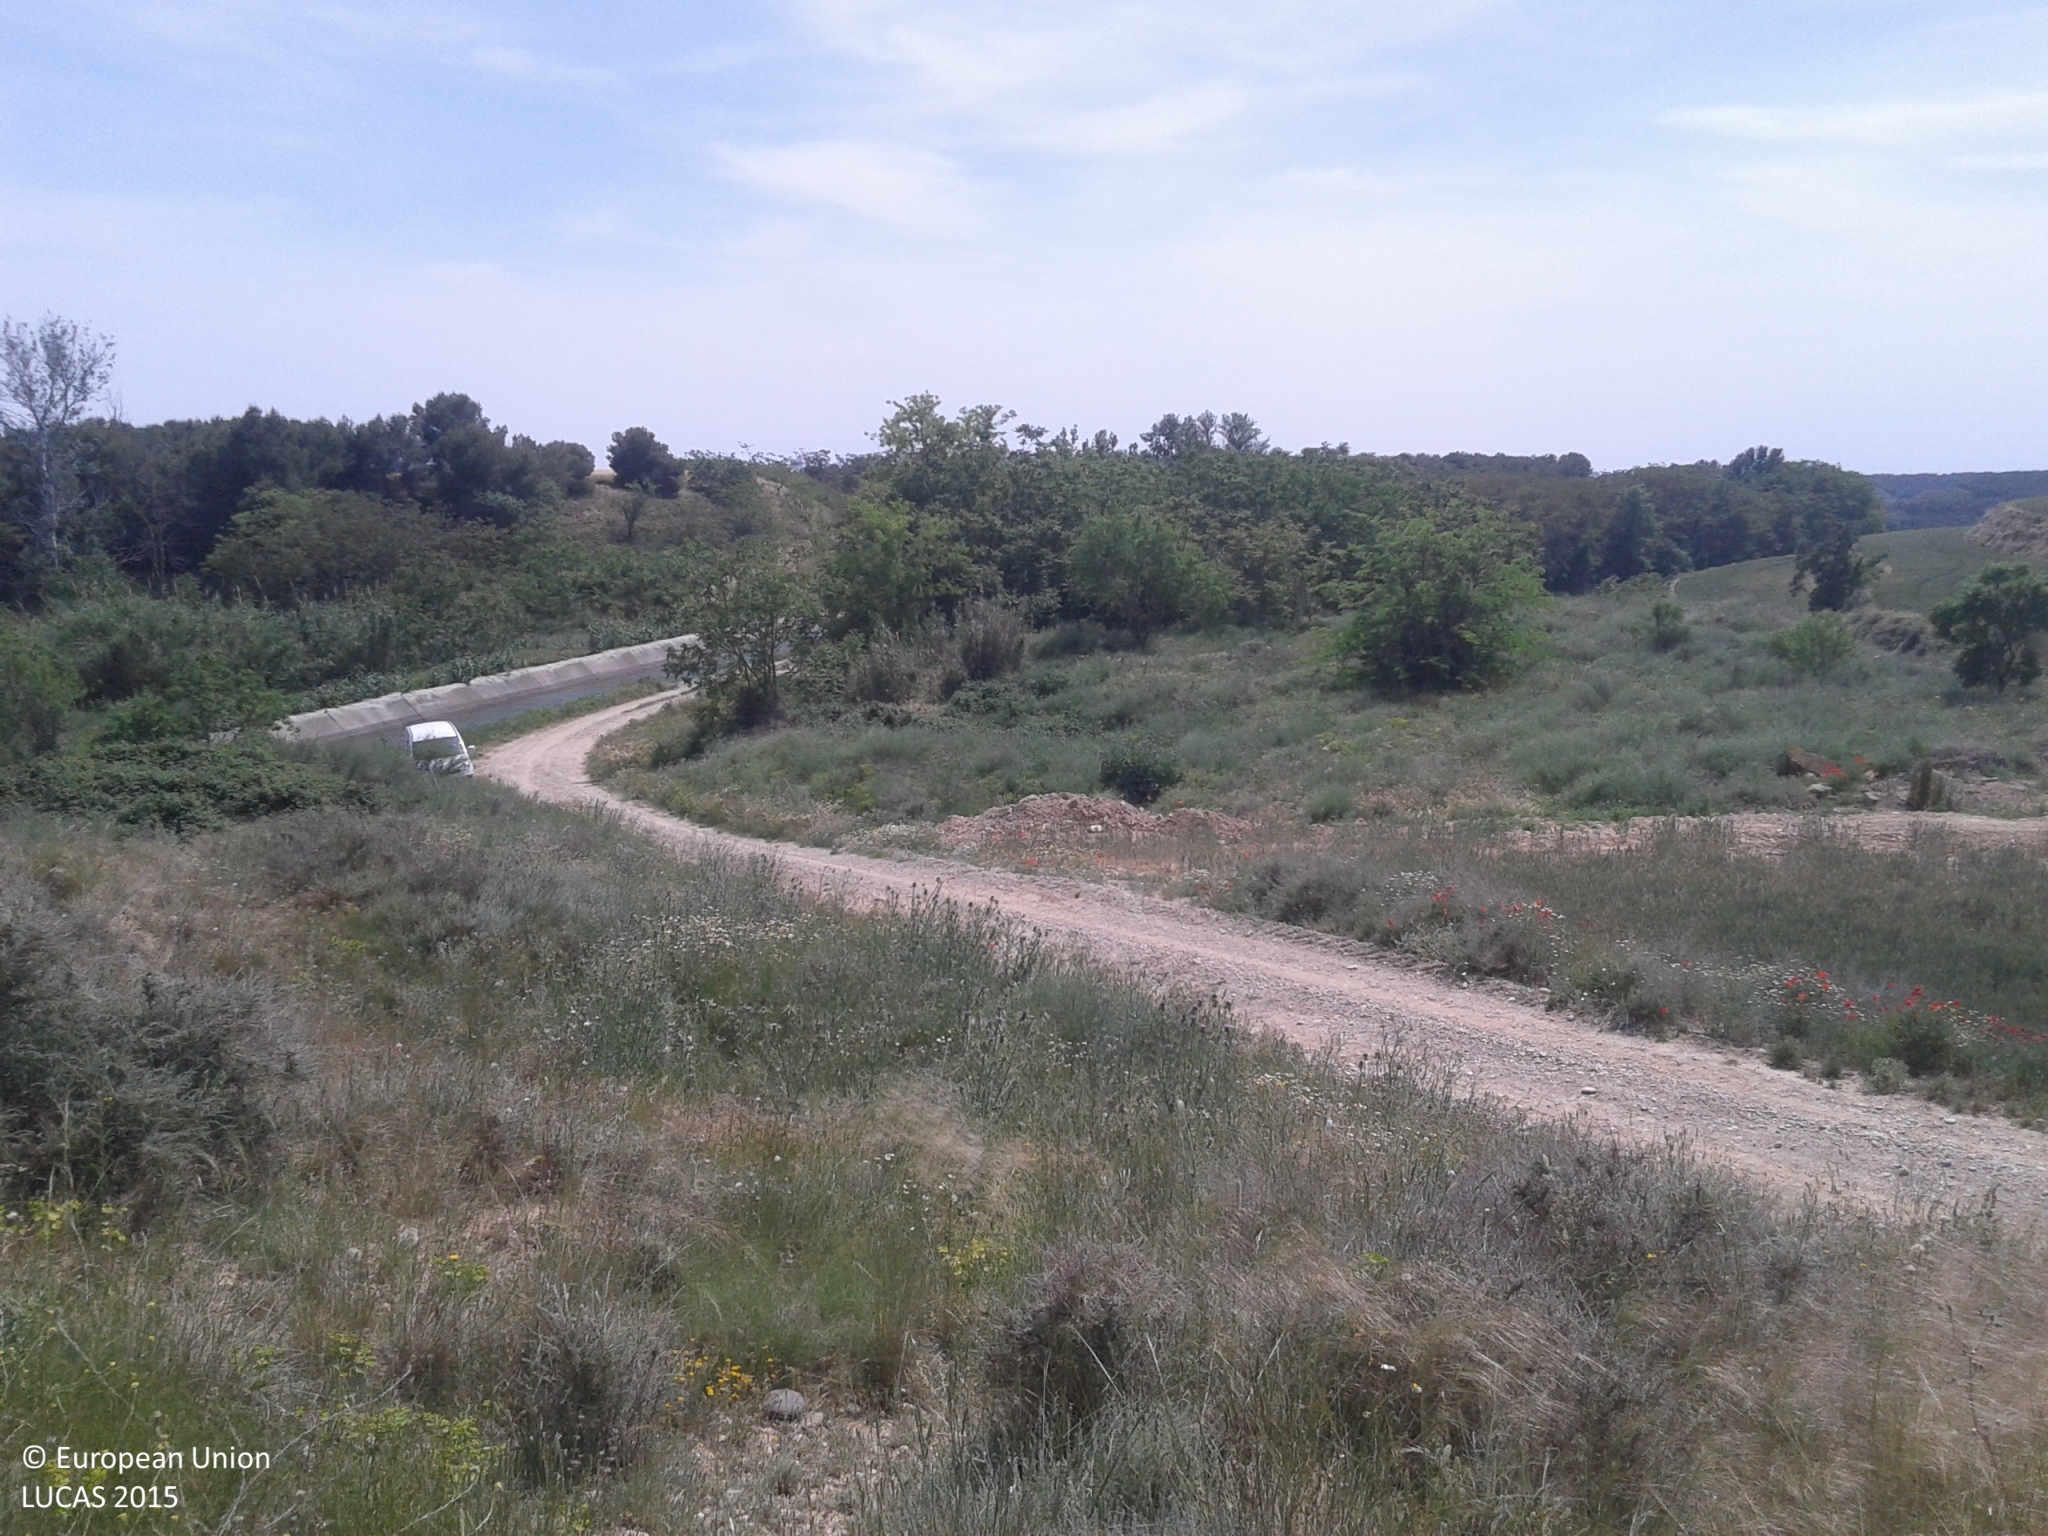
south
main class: Shrubland
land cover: Shrubland with sparse tree cover
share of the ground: 50 - 75 %
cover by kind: shrubs 60 %, herbaceous plants 35 %, coniferous forest trees 5 %
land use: Semi-natural and natural areas not in use
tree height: > 5 m
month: May
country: ES
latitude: 41.7923
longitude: 0.5394
